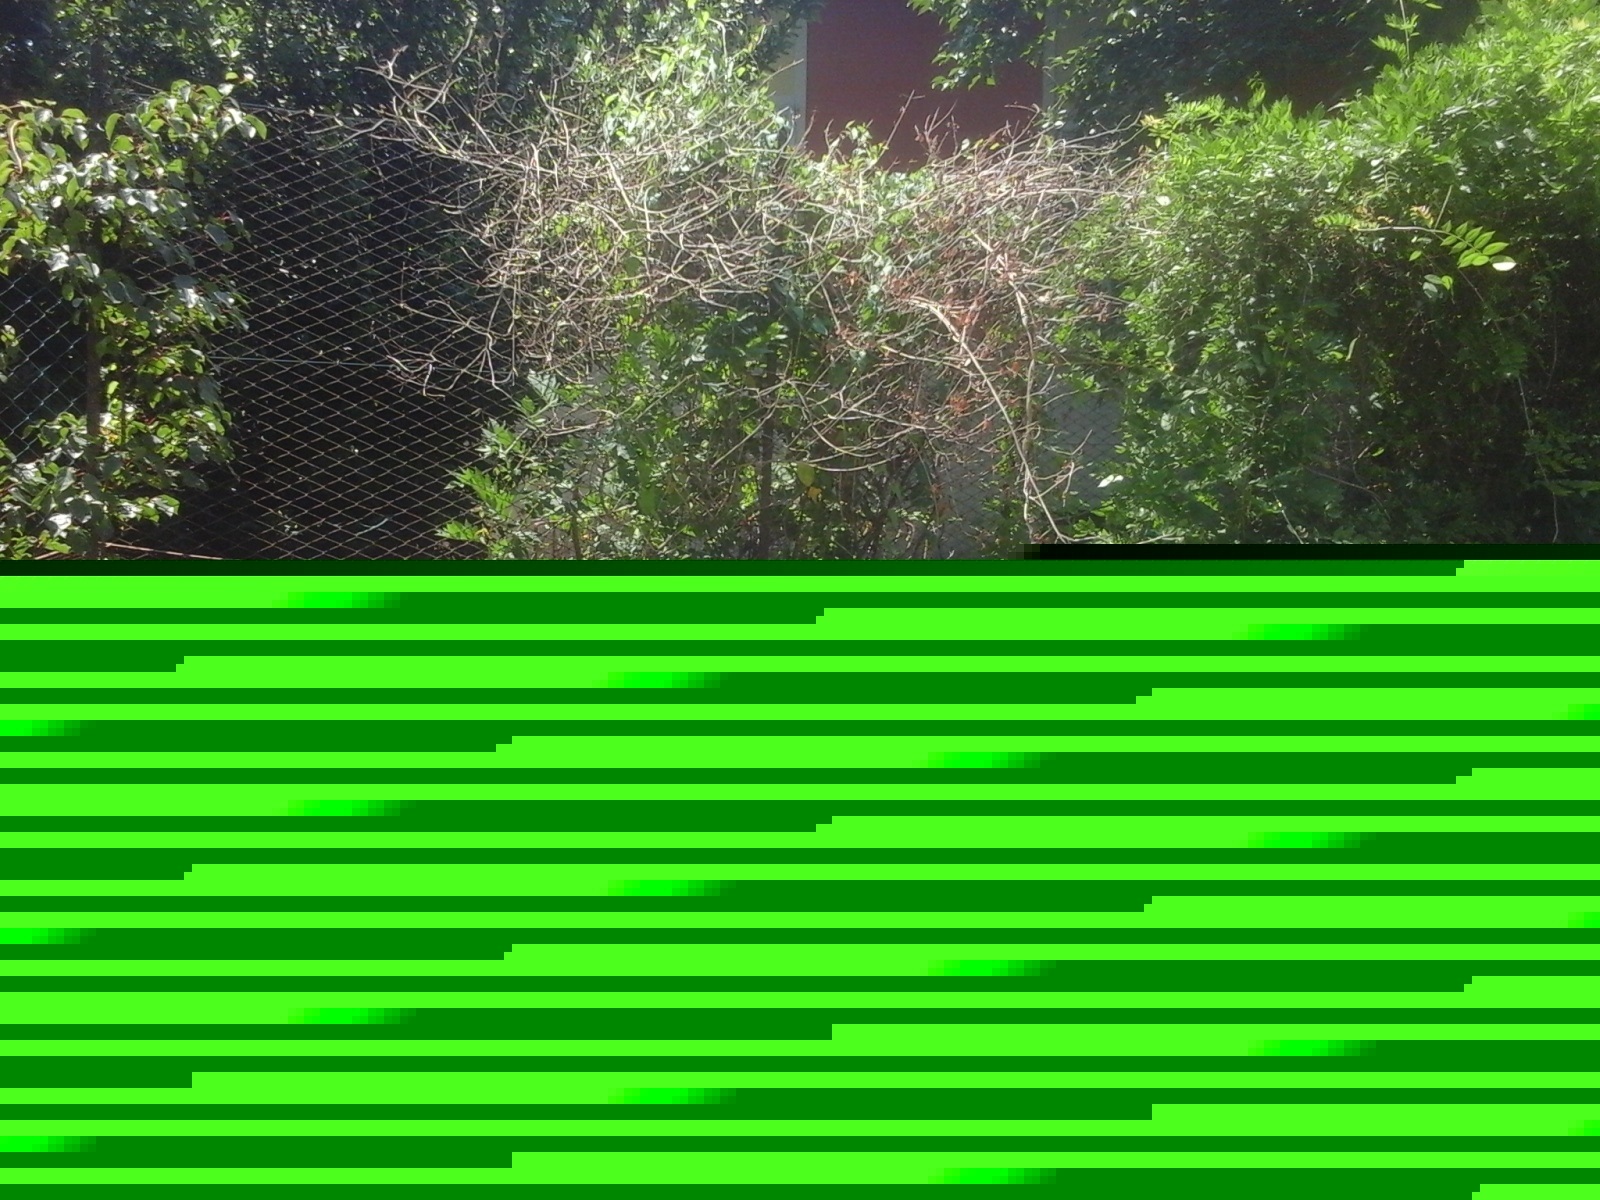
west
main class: Woodland
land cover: Broadleaved woodland
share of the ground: > 75 %
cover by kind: broadleaved forest trees 85 %, shrubs 10 %, herbaceous plants 5 %
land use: Residential
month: June
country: IT
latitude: 45.7008
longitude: 9.3717
